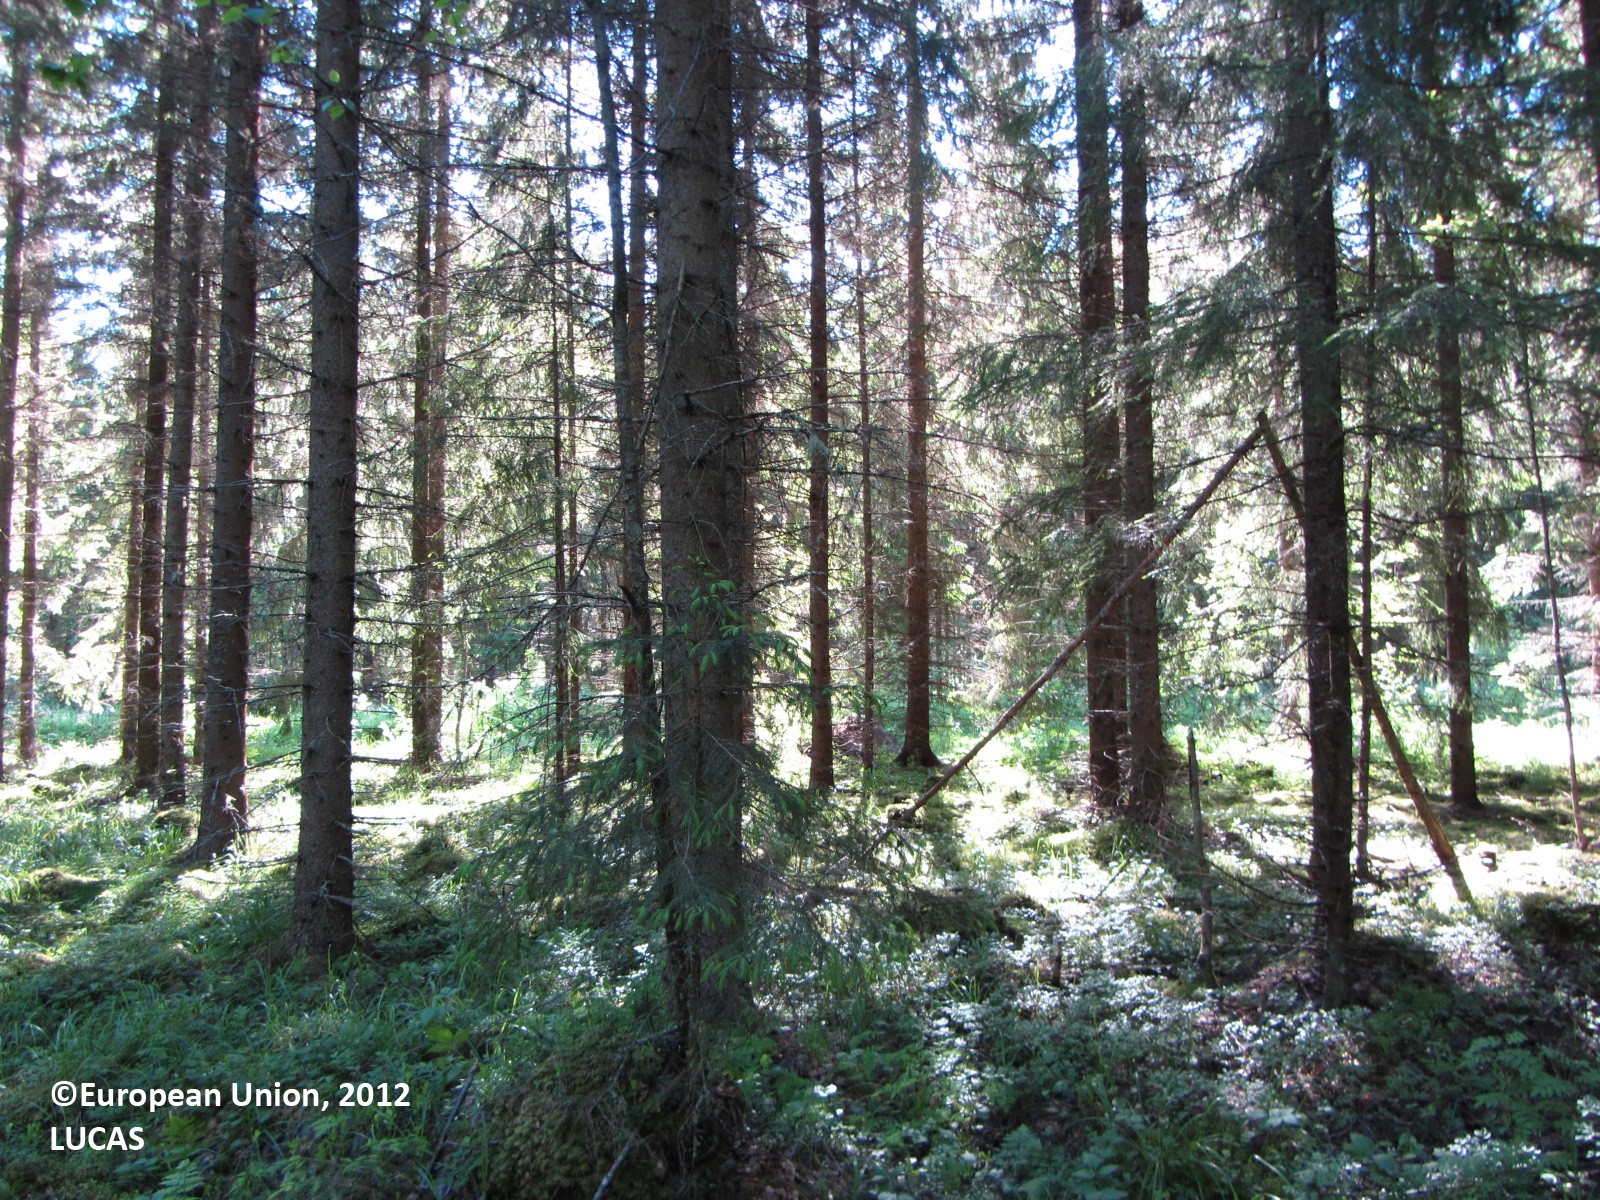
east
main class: Woodland
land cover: Spruce dominated mixed woodland
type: boreal forest
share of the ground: 50 - 75 %
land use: Forestry
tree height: > 5 m
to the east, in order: Spruce dominated mixed woodland; Spruce dominated coniferous woodland; Ditches and canals; Grass margins; Tracks; Grassland without tree/shrub cover; Spruce dominated coniferous woodland; Tracks; Spruce dominated coniferous woodland; Shrubland with sparse tree cover; Other mixed woodland; Grassland without tree/shrub cover; Spruce dominated coniferous woodland
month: June
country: FI
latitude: 62.0174
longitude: 25.7306
